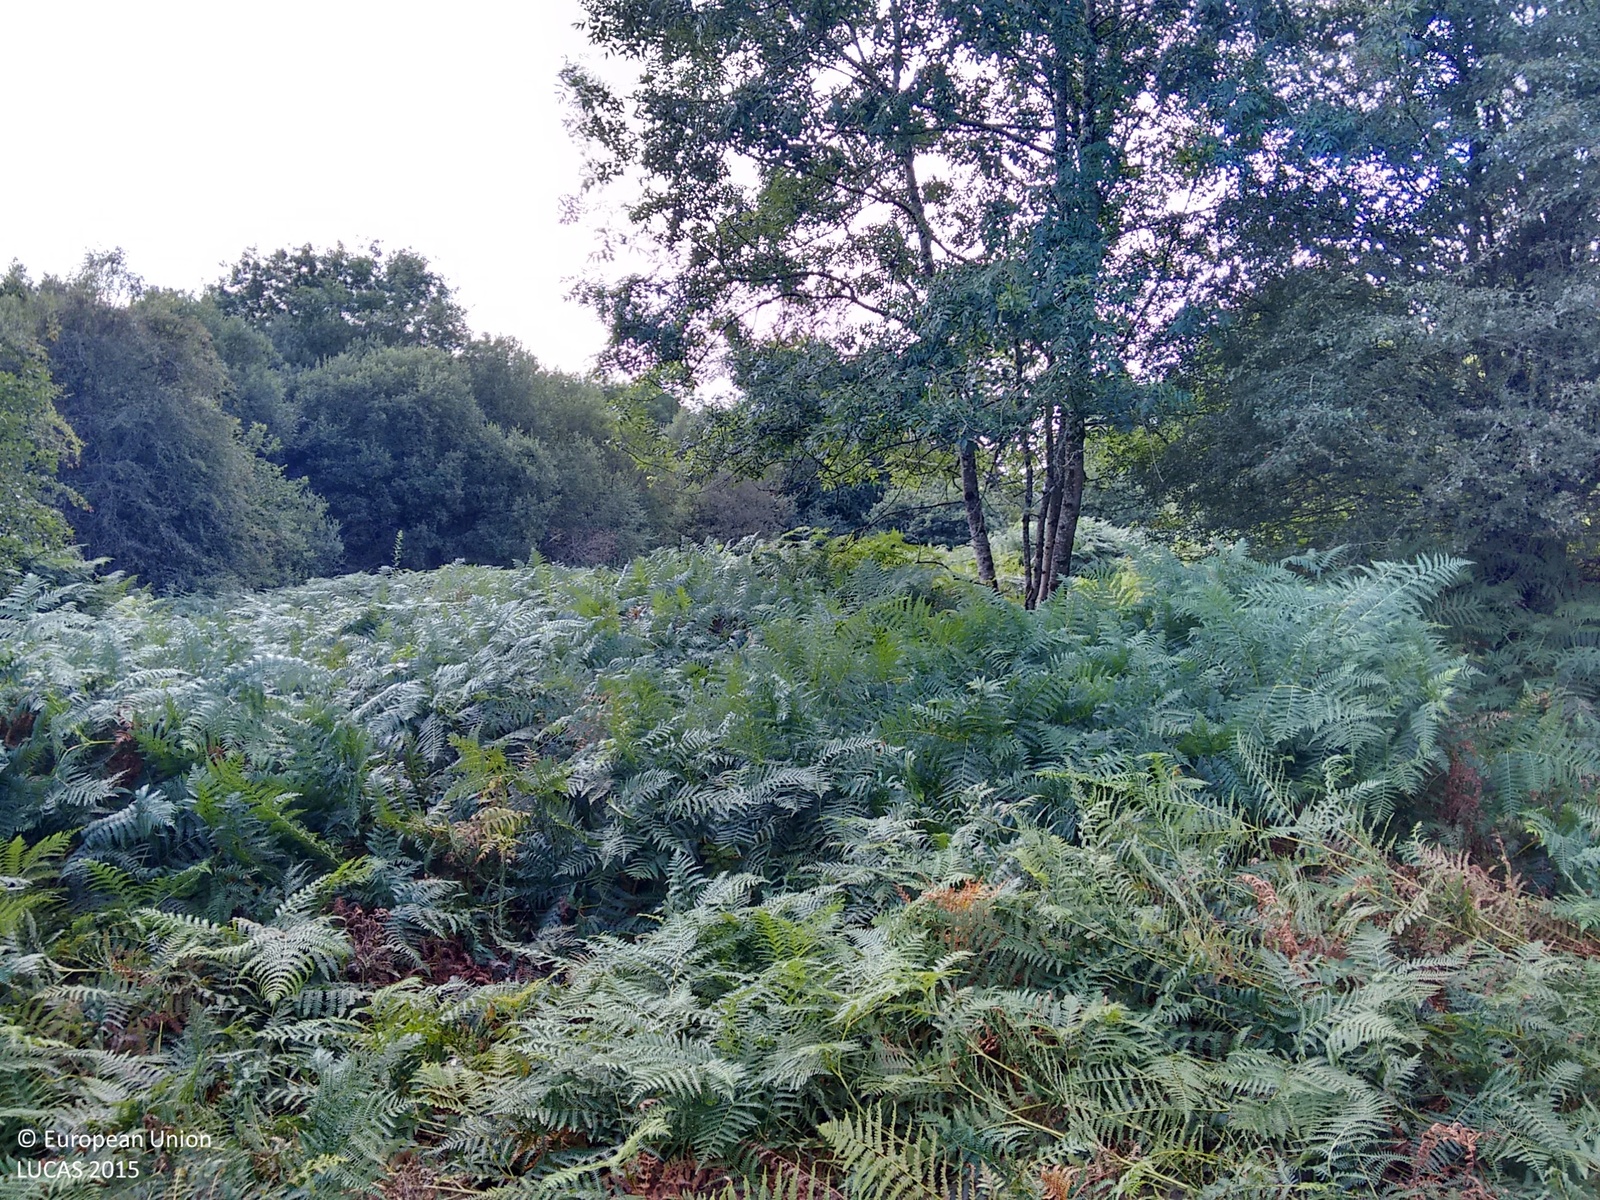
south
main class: Woodland
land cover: Broadleaved woodland
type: mesophytic deciduous forest
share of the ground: > 75 %
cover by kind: herbaceous plants 80 %, broadleaved forest trees 20 %
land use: Agriculture (excluding fallow land and kitchen gardens)
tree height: < 5 m
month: September
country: GB
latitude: 52.1504
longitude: -3.4861
